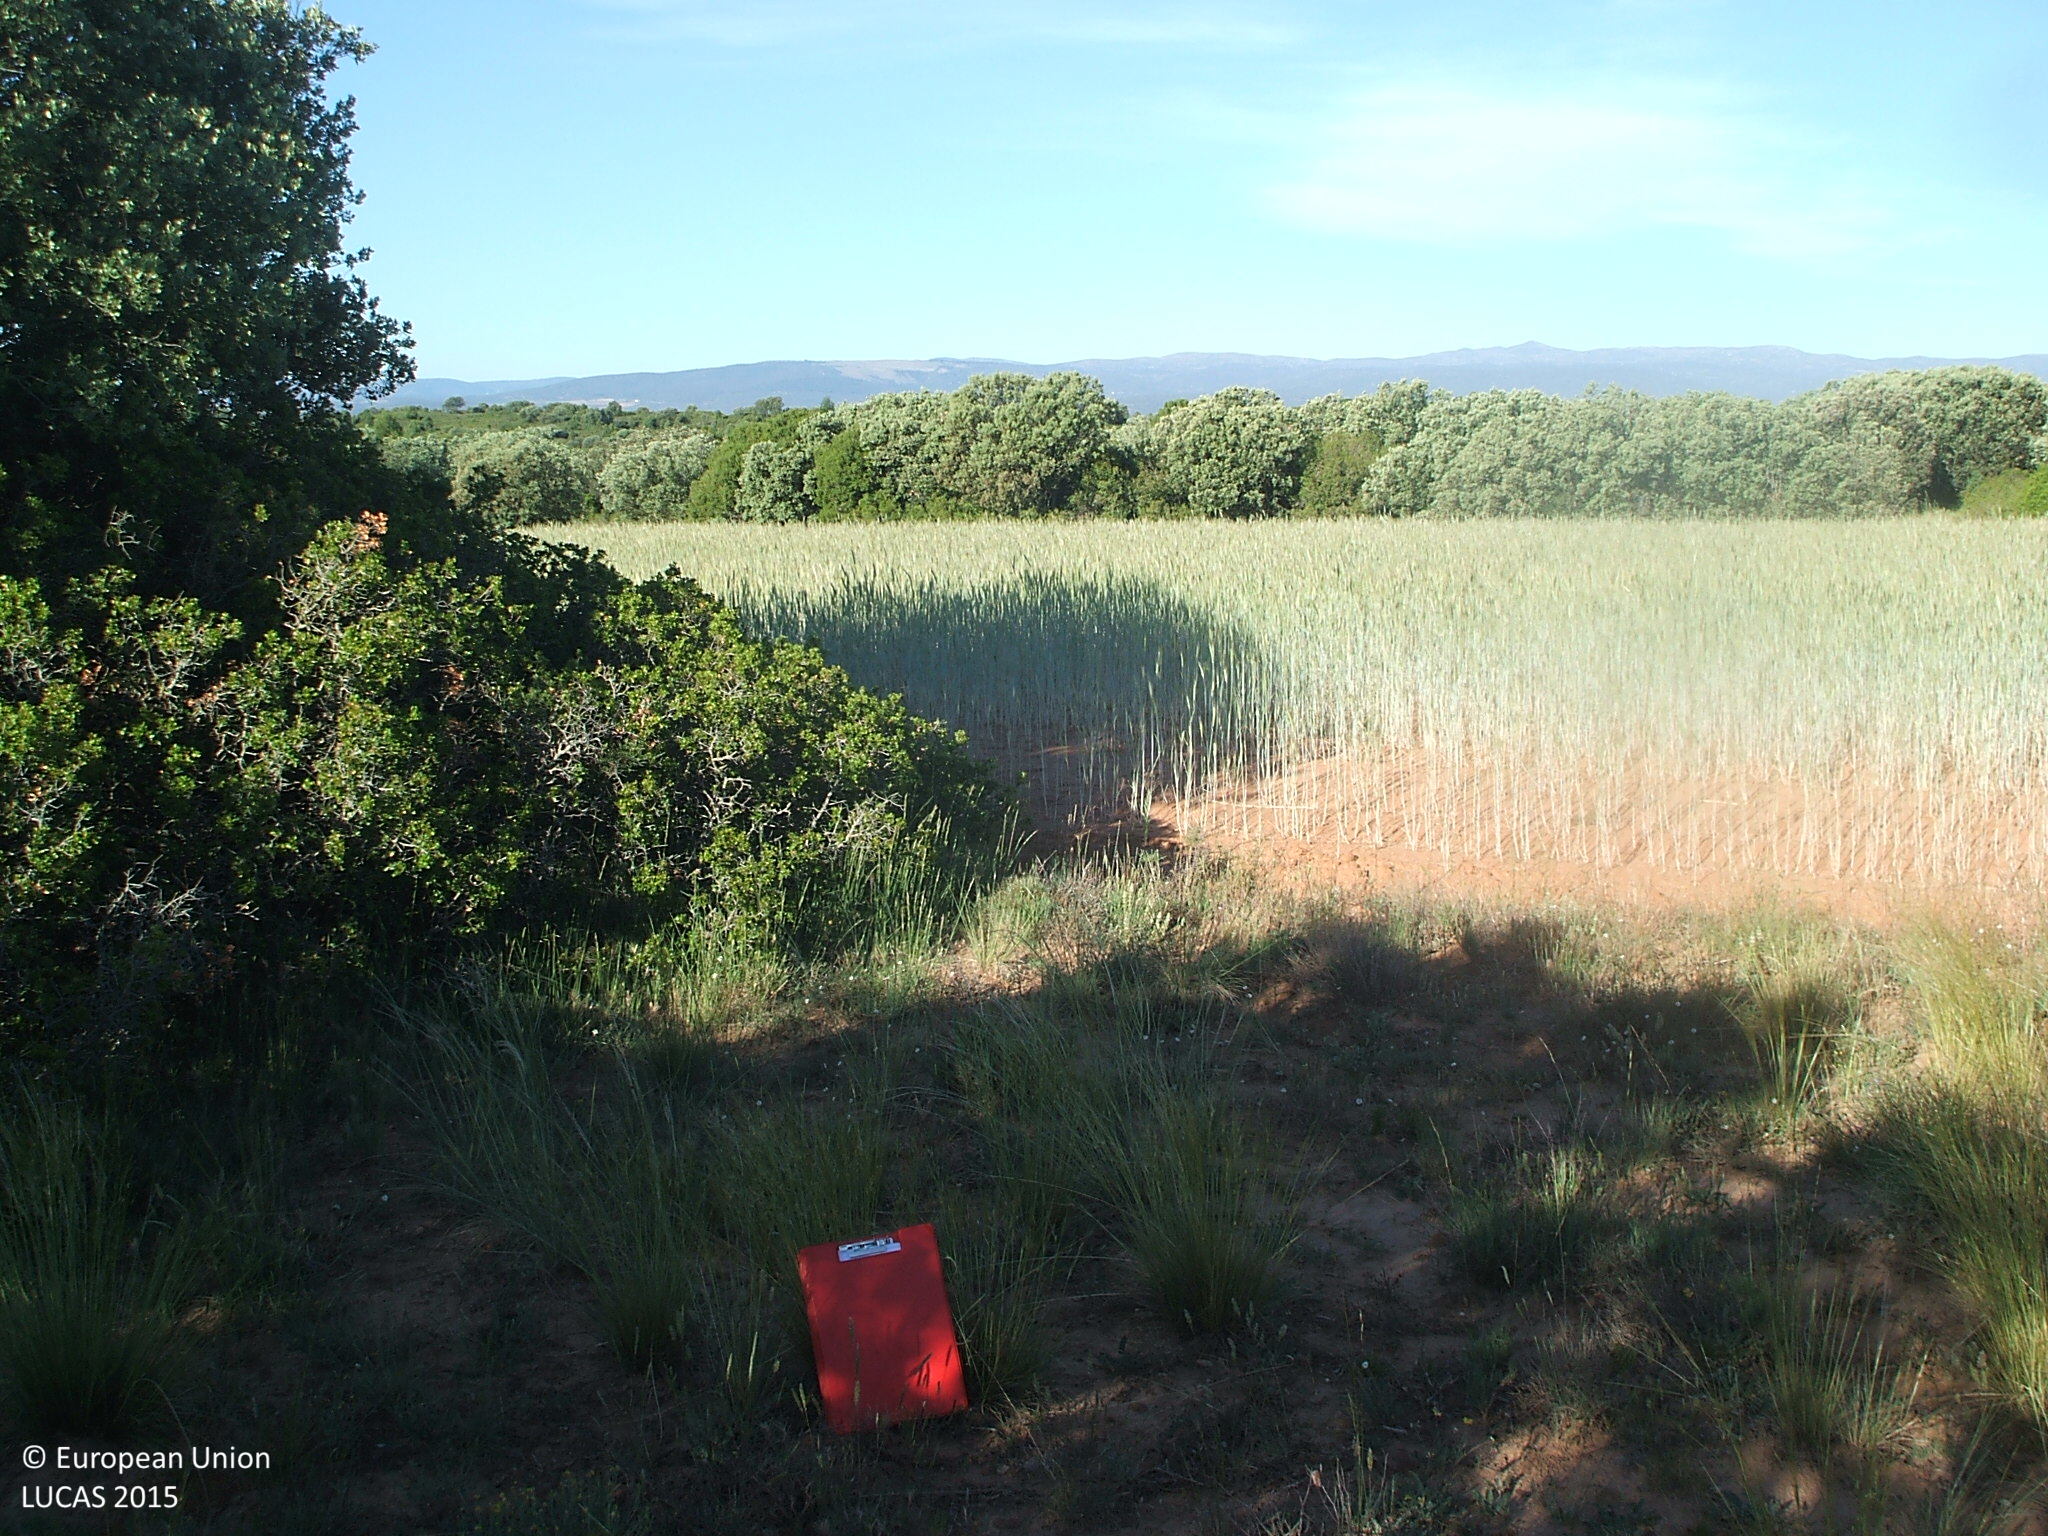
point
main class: Woodland
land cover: Other mixed woodland
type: coniferous forest of the mediterranean region
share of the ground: > 75 %
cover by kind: coniferous forest trees 30 %, broadleaved forest trees 30 %, shrubs 20 %, unconsolidated bare surface 20 %
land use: Semi-natural and natural areas not in use
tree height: > 5 m
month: May
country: ES
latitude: 40.2005
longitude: -0.7796
